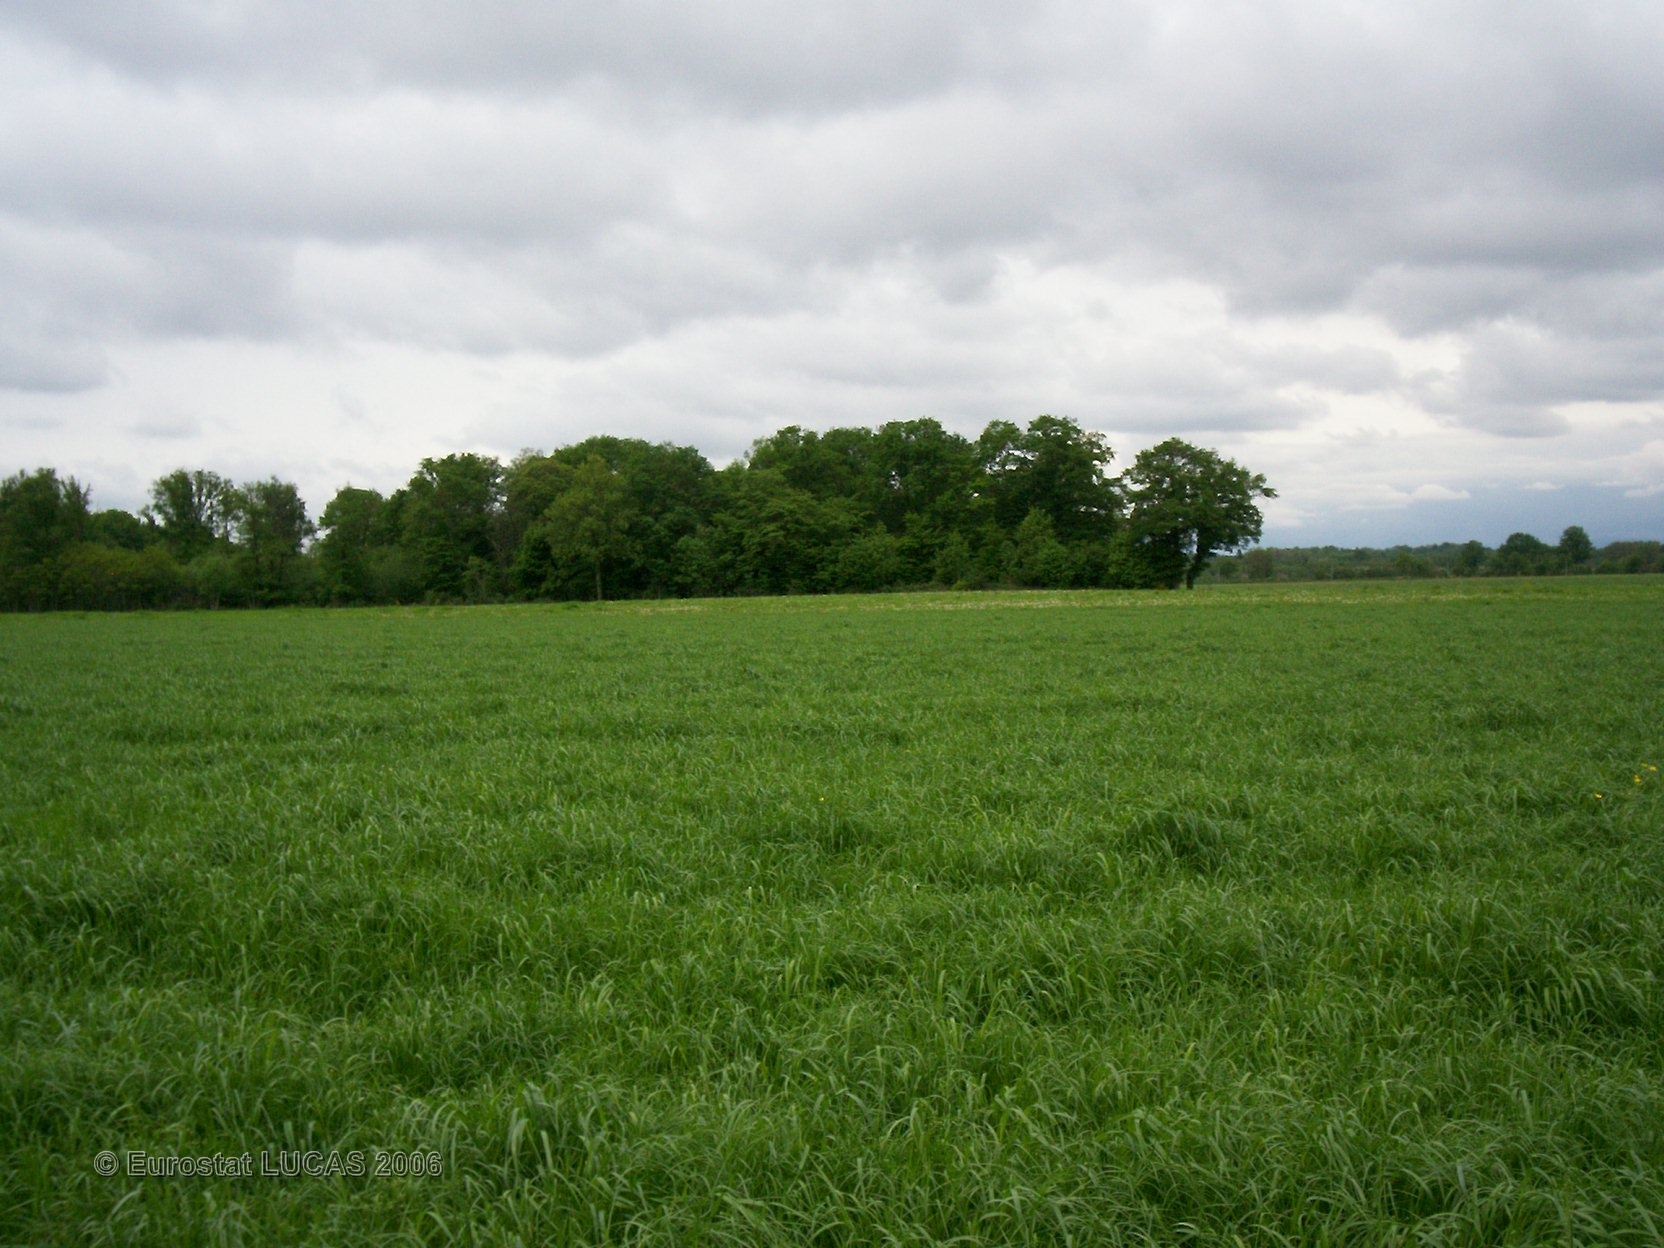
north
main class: Grassland
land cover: Grassland without tree/shrub cover
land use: Agriculture (excluding fallow land and kitchen gardens)
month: May
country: FR
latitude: 46.0263
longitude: 5.1847
